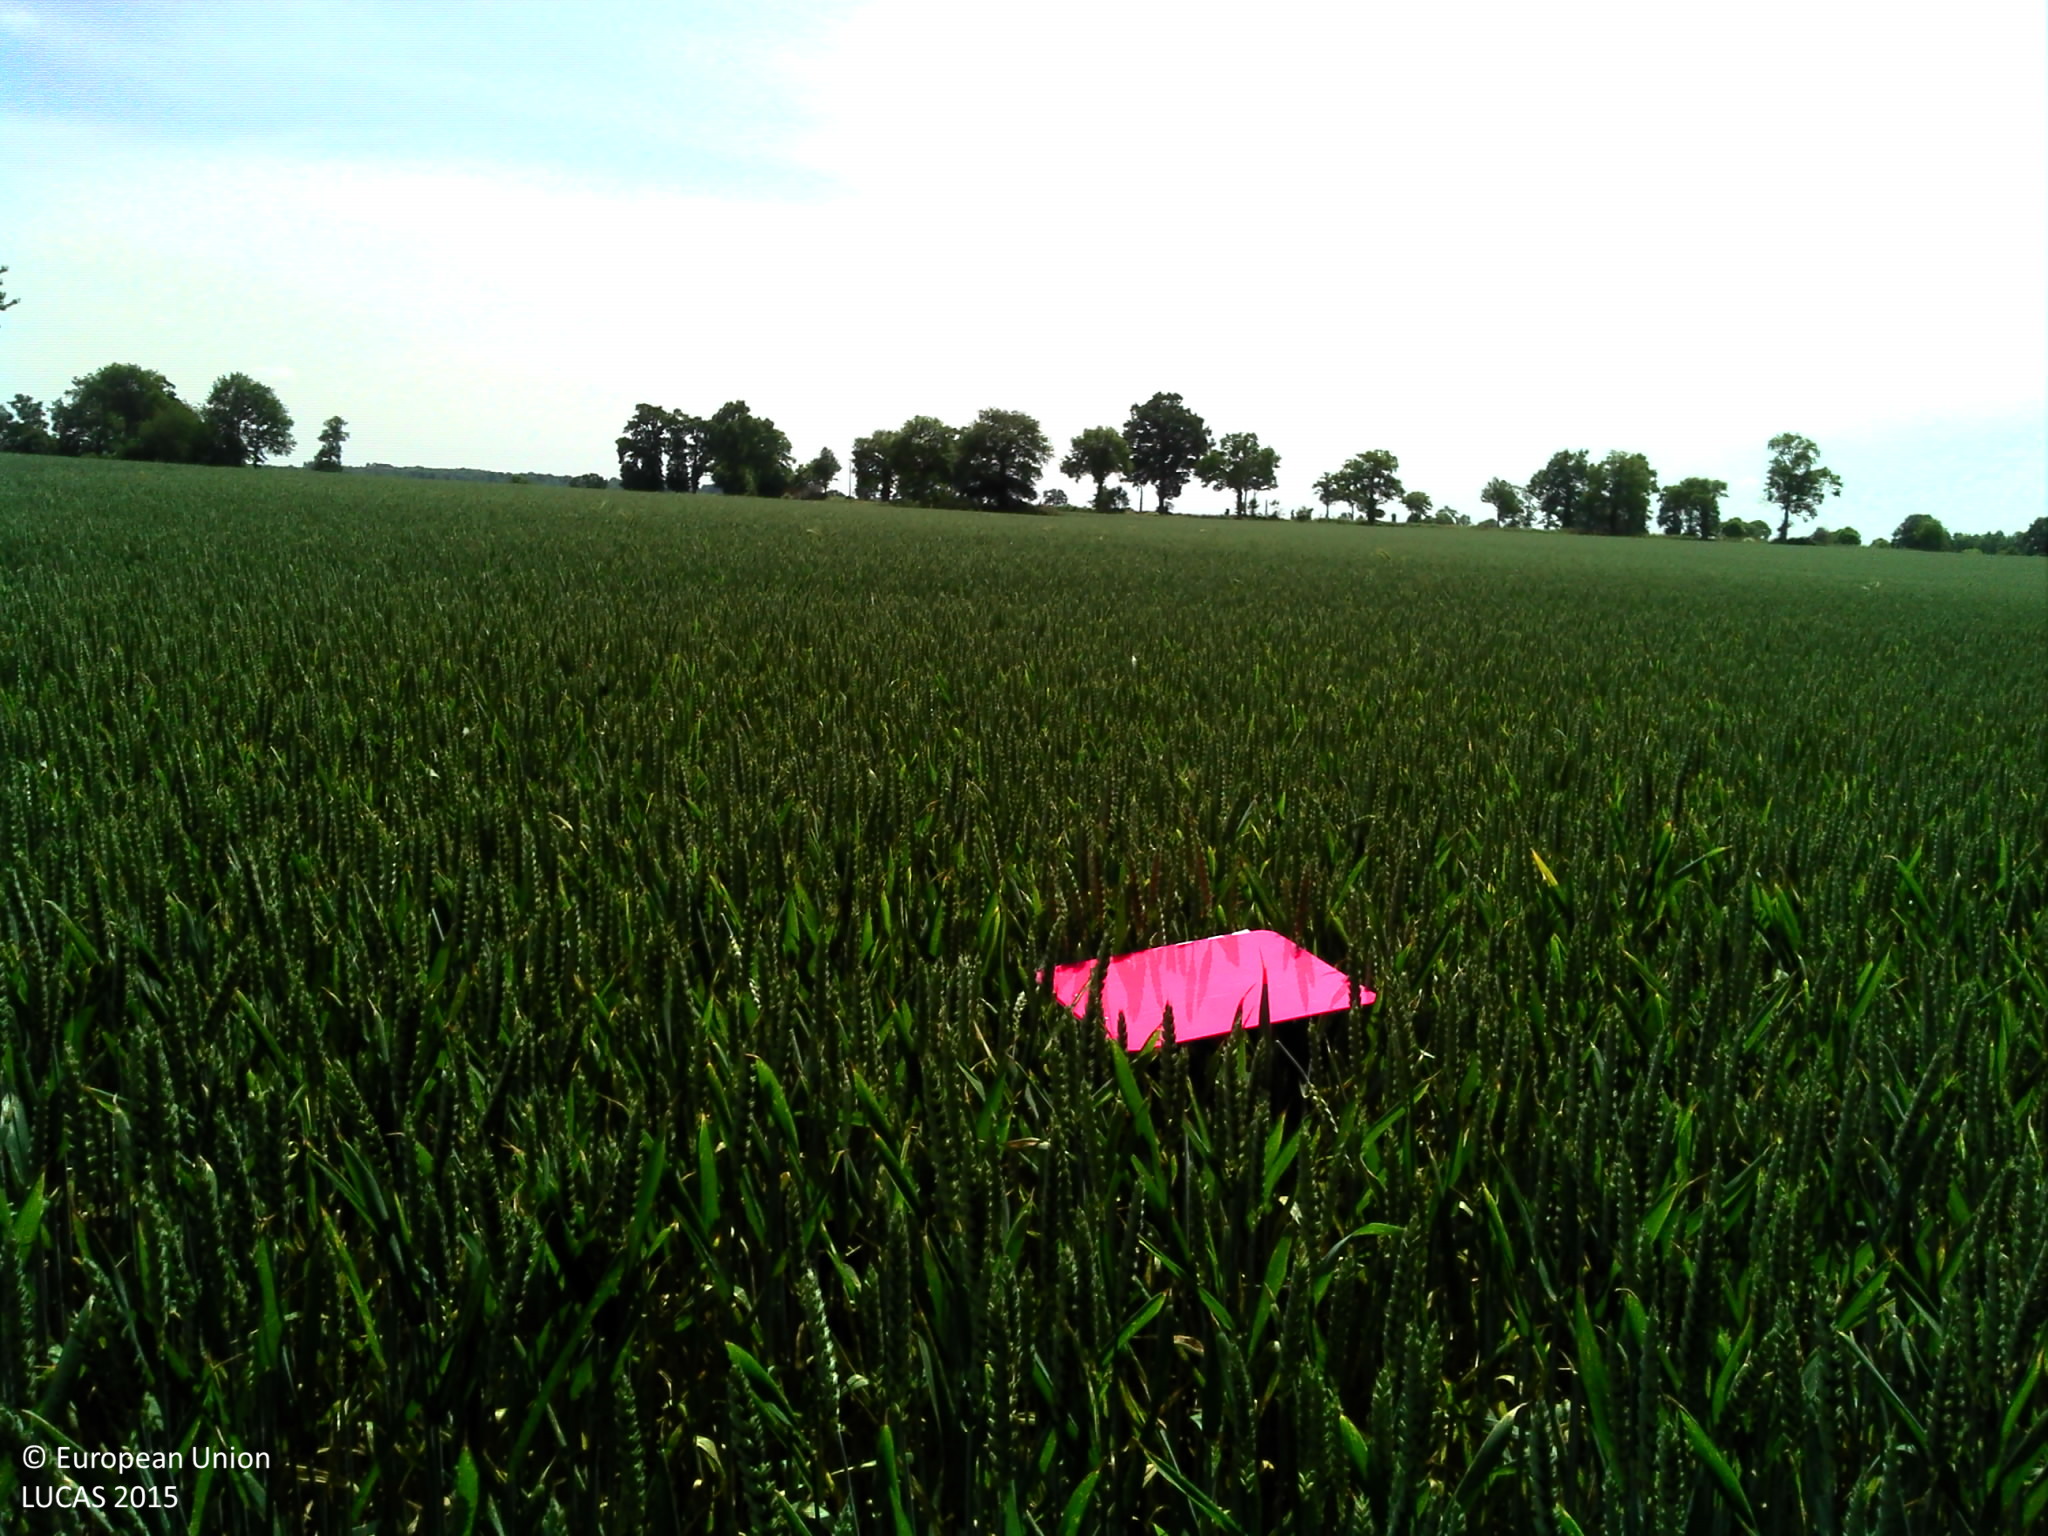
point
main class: Cropland
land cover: Common wheat
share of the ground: > 75 %
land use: Agriculture (excluding fallow land and kitchen gardens)
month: June
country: FR
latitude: 48.3668
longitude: -1.4794
